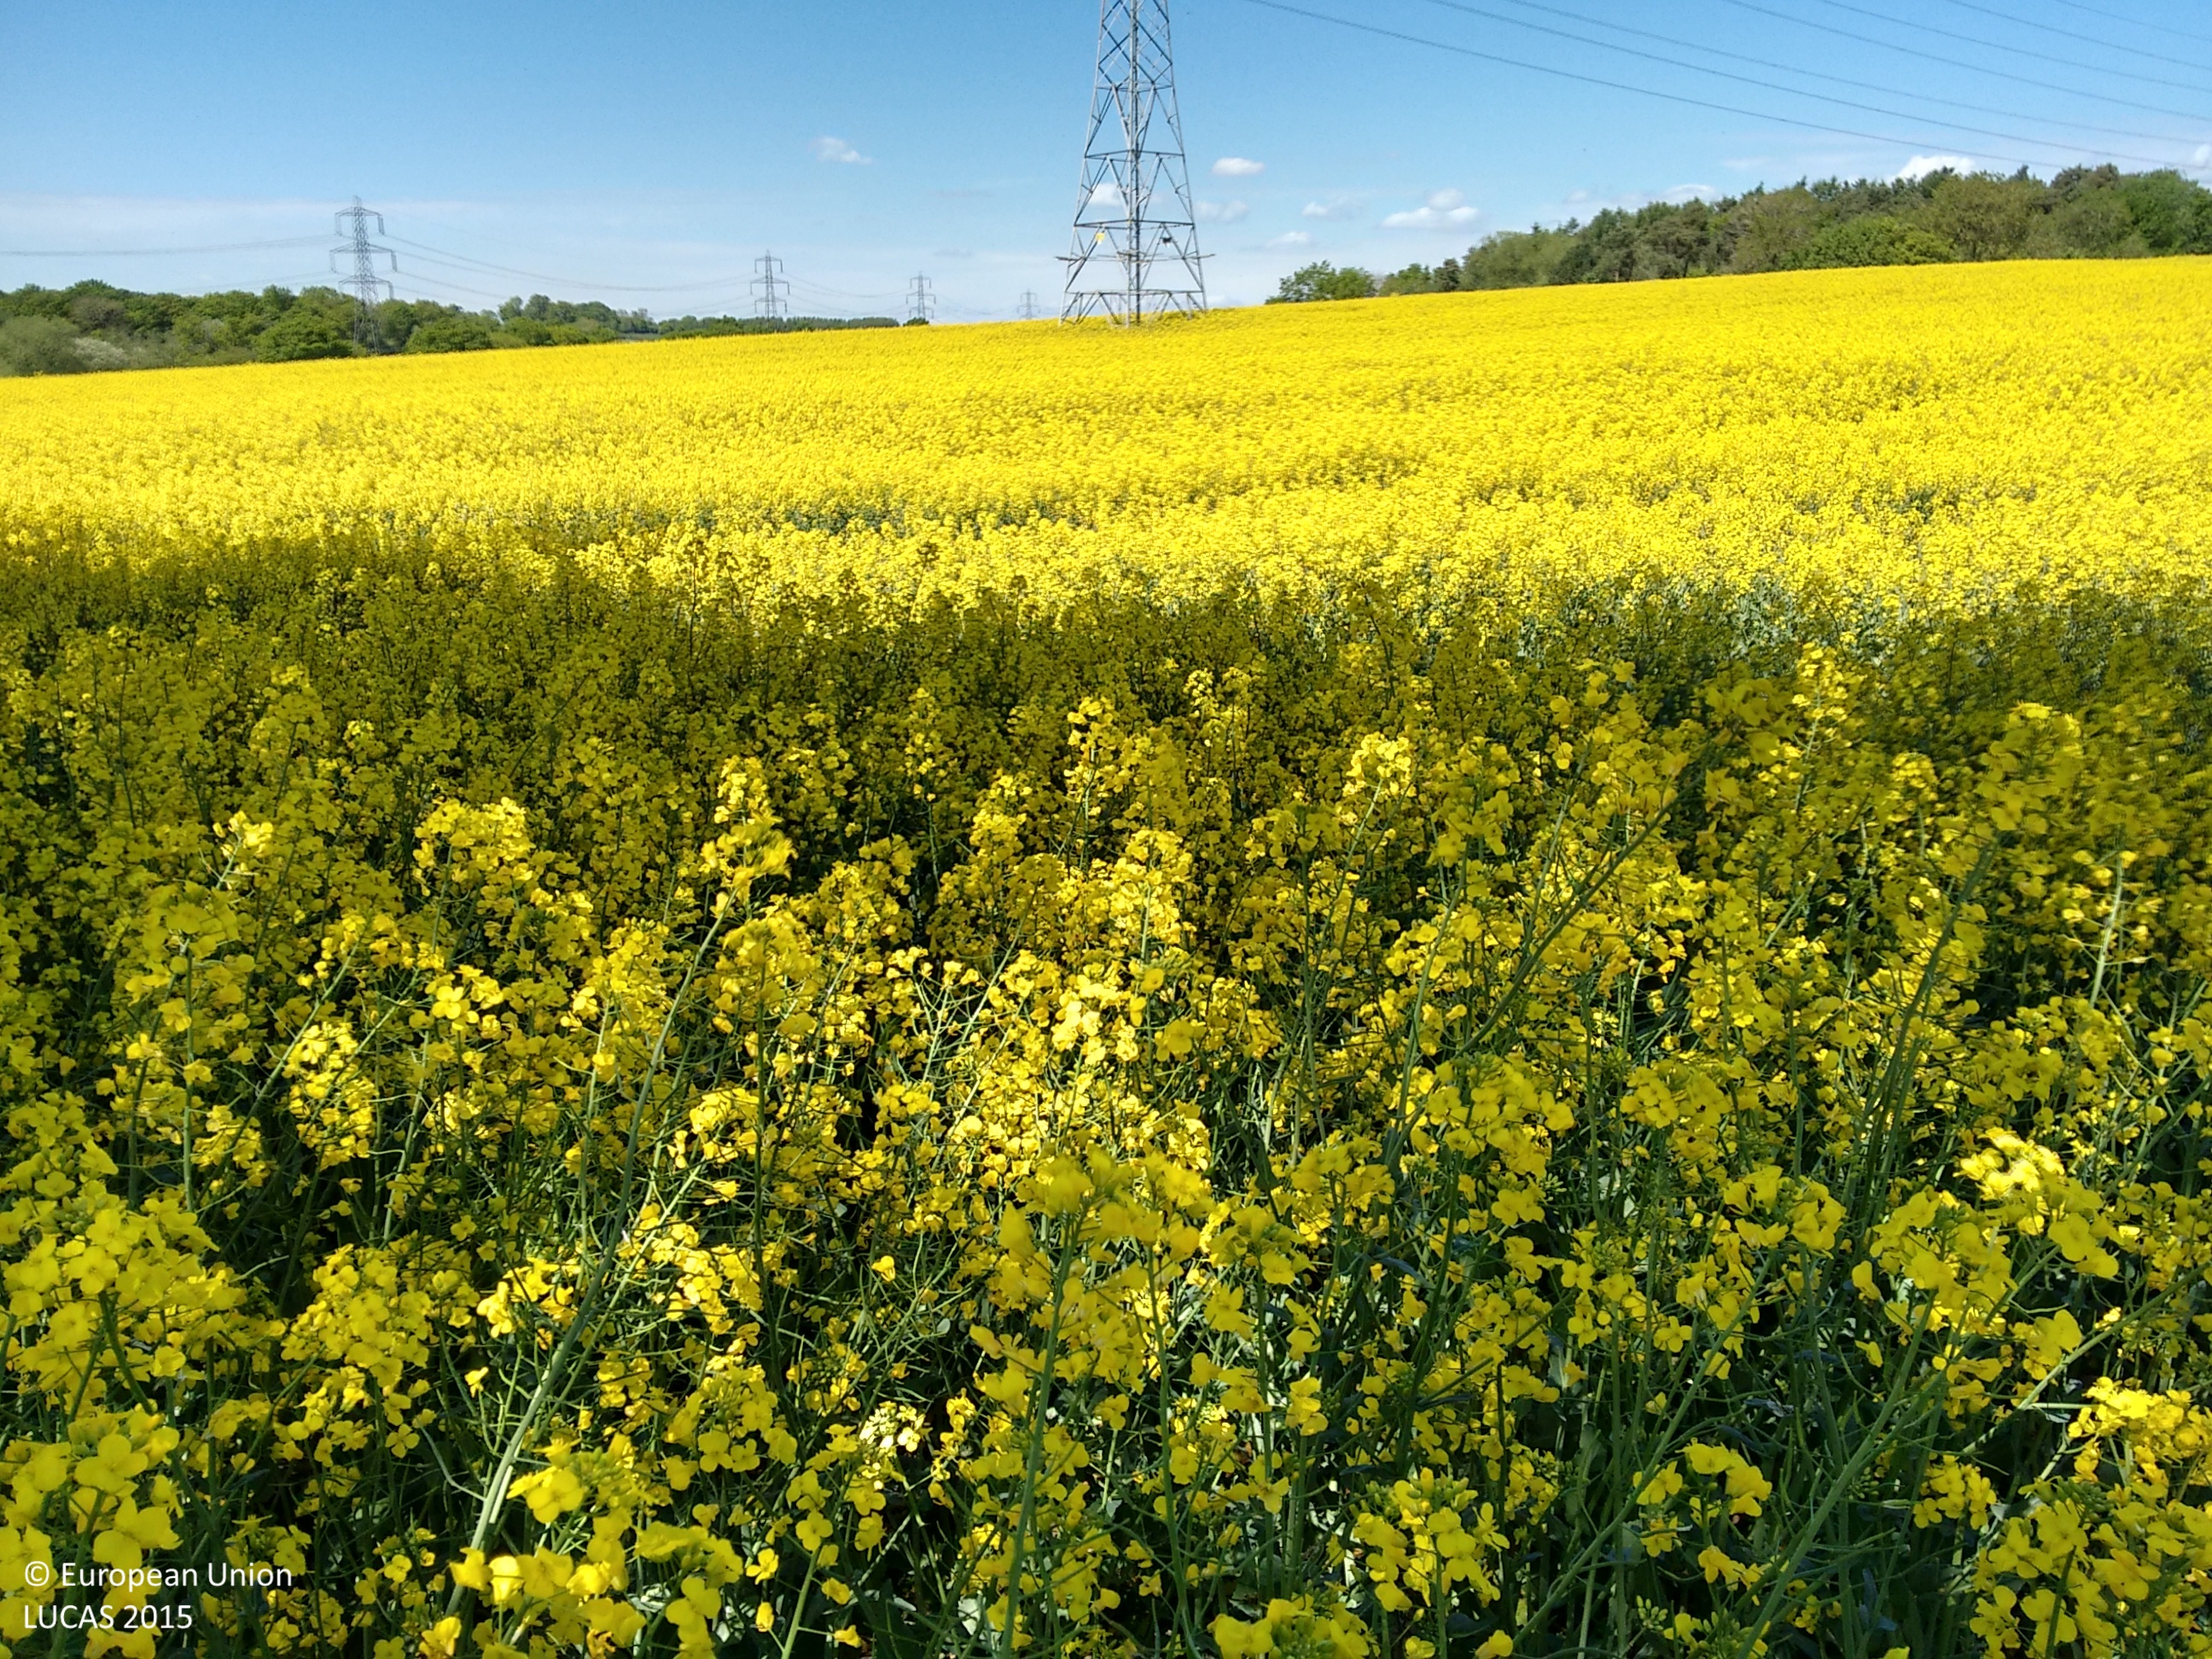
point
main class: Cropland
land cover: Rape and turnip rape
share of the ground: > 75 %
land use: Agriculture (excluding fallow land and kitchen gardens)
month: May
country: GB
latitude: 51.3508
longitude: -1.0582
